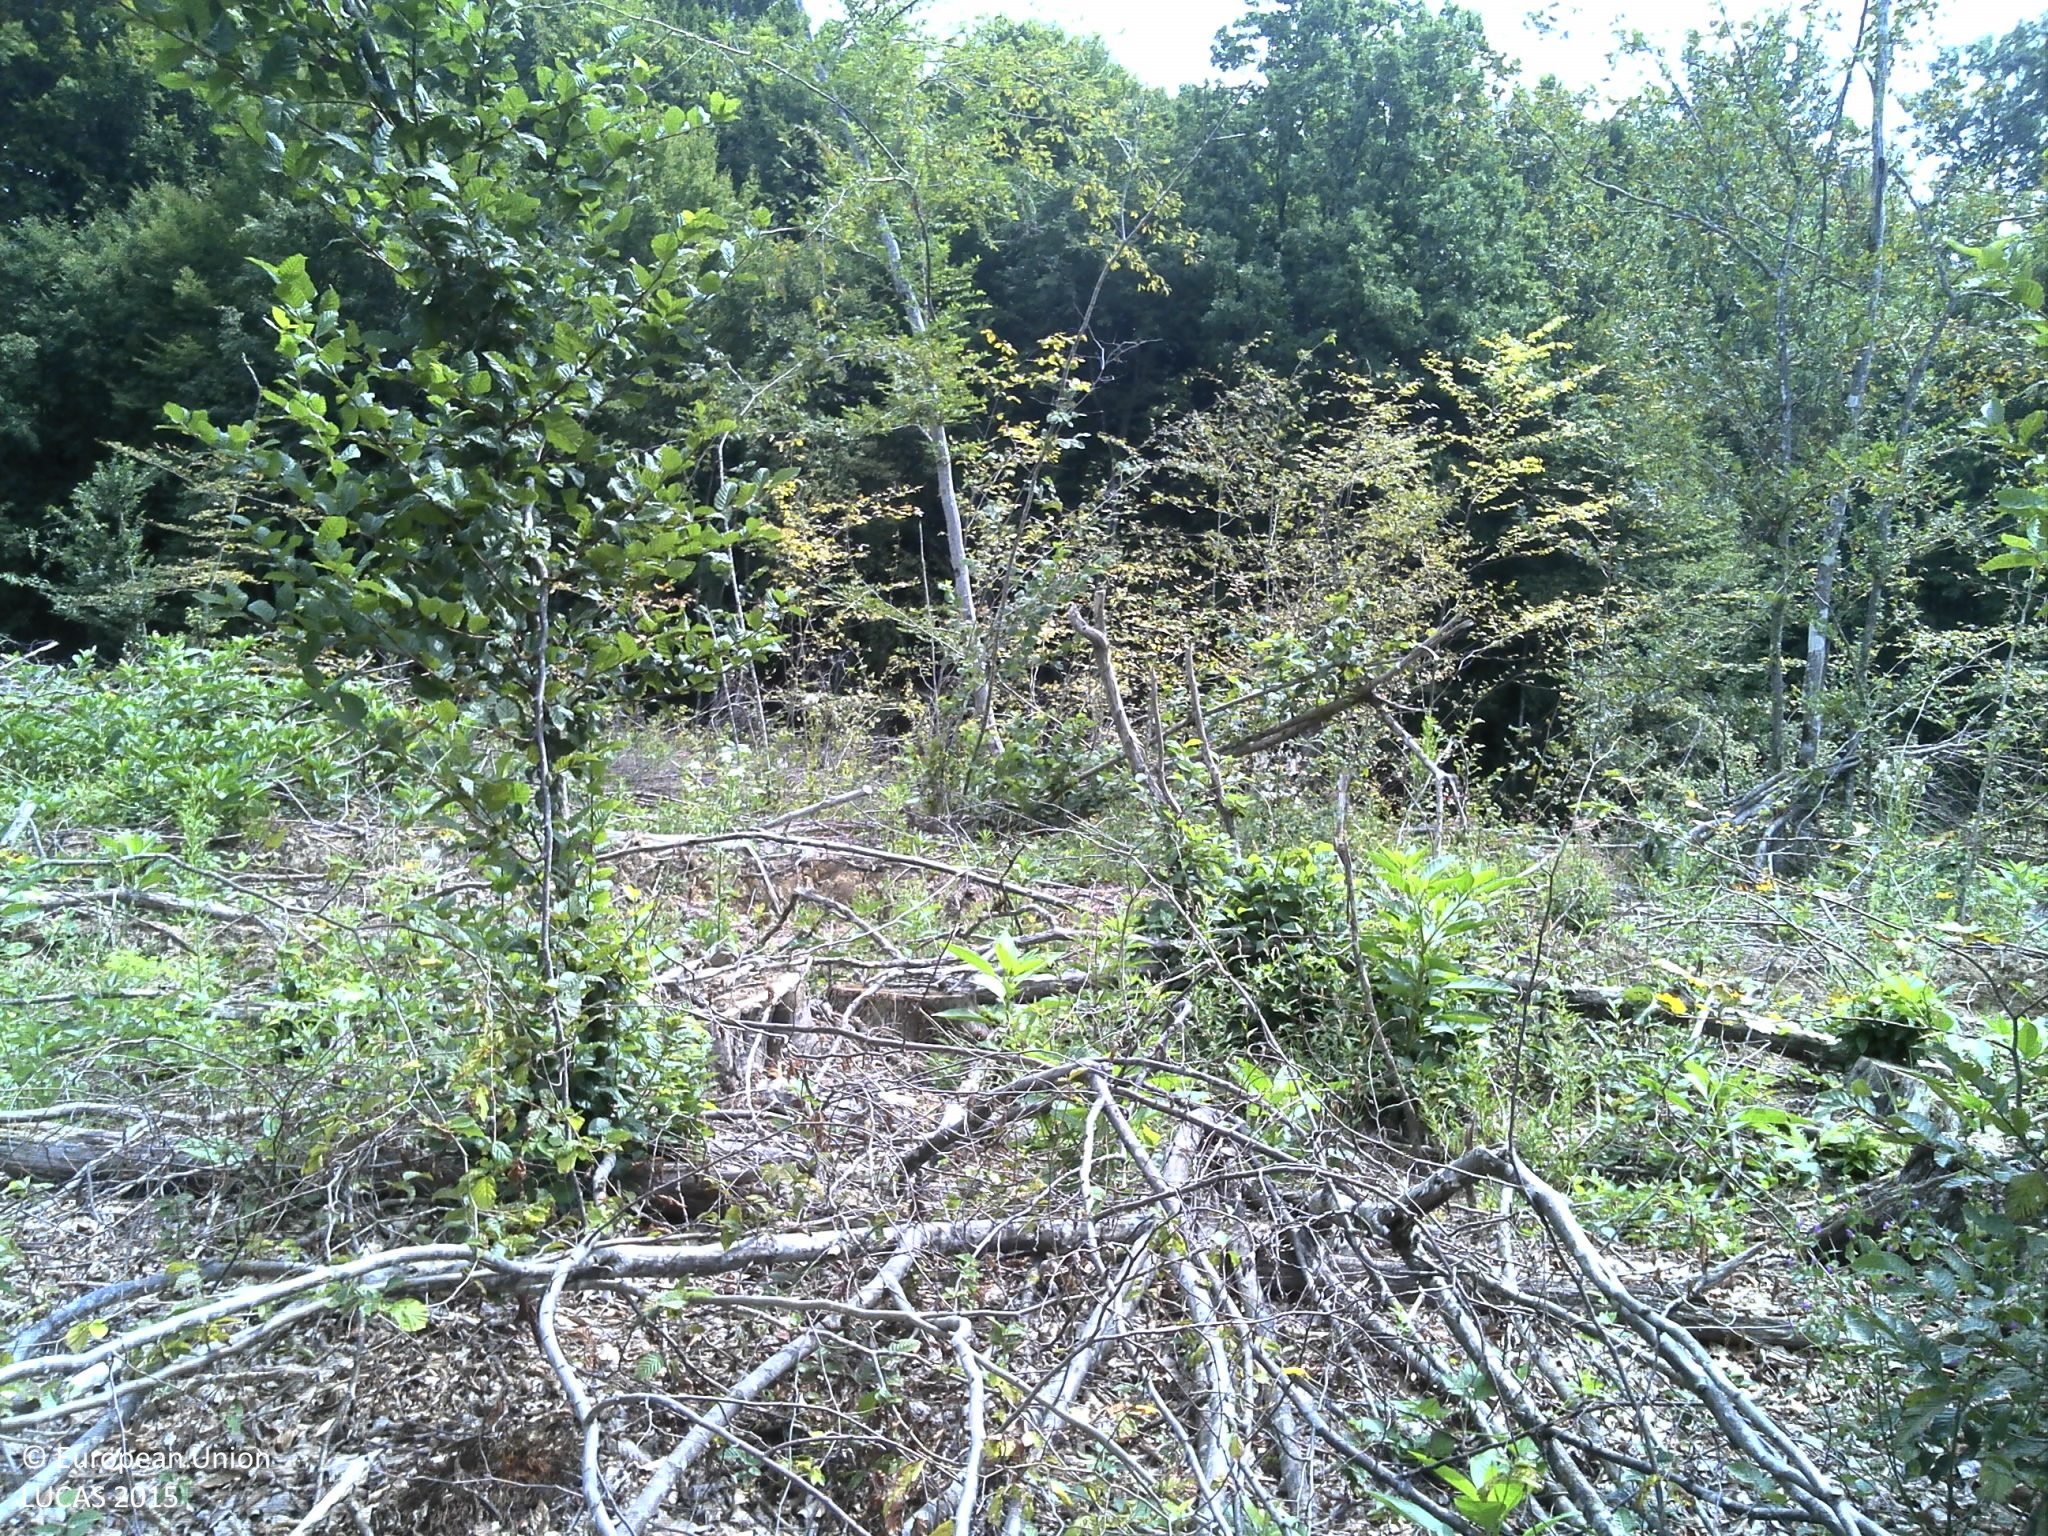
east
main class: Woodland
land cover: Broadleaved woodland
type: beech forest
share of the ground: > 75 %
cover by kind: broadleaved forest trees 100 %
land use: Forestry
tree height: > 5 m
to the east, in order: Broadleaved woodland; Spontaneously vegetated surfaces; Tracks; Fences; Spontaneously vegetated surfaces; Fences; Broadleaved woodland
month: August
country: HR
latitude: 45.3363
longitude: 15.9557
